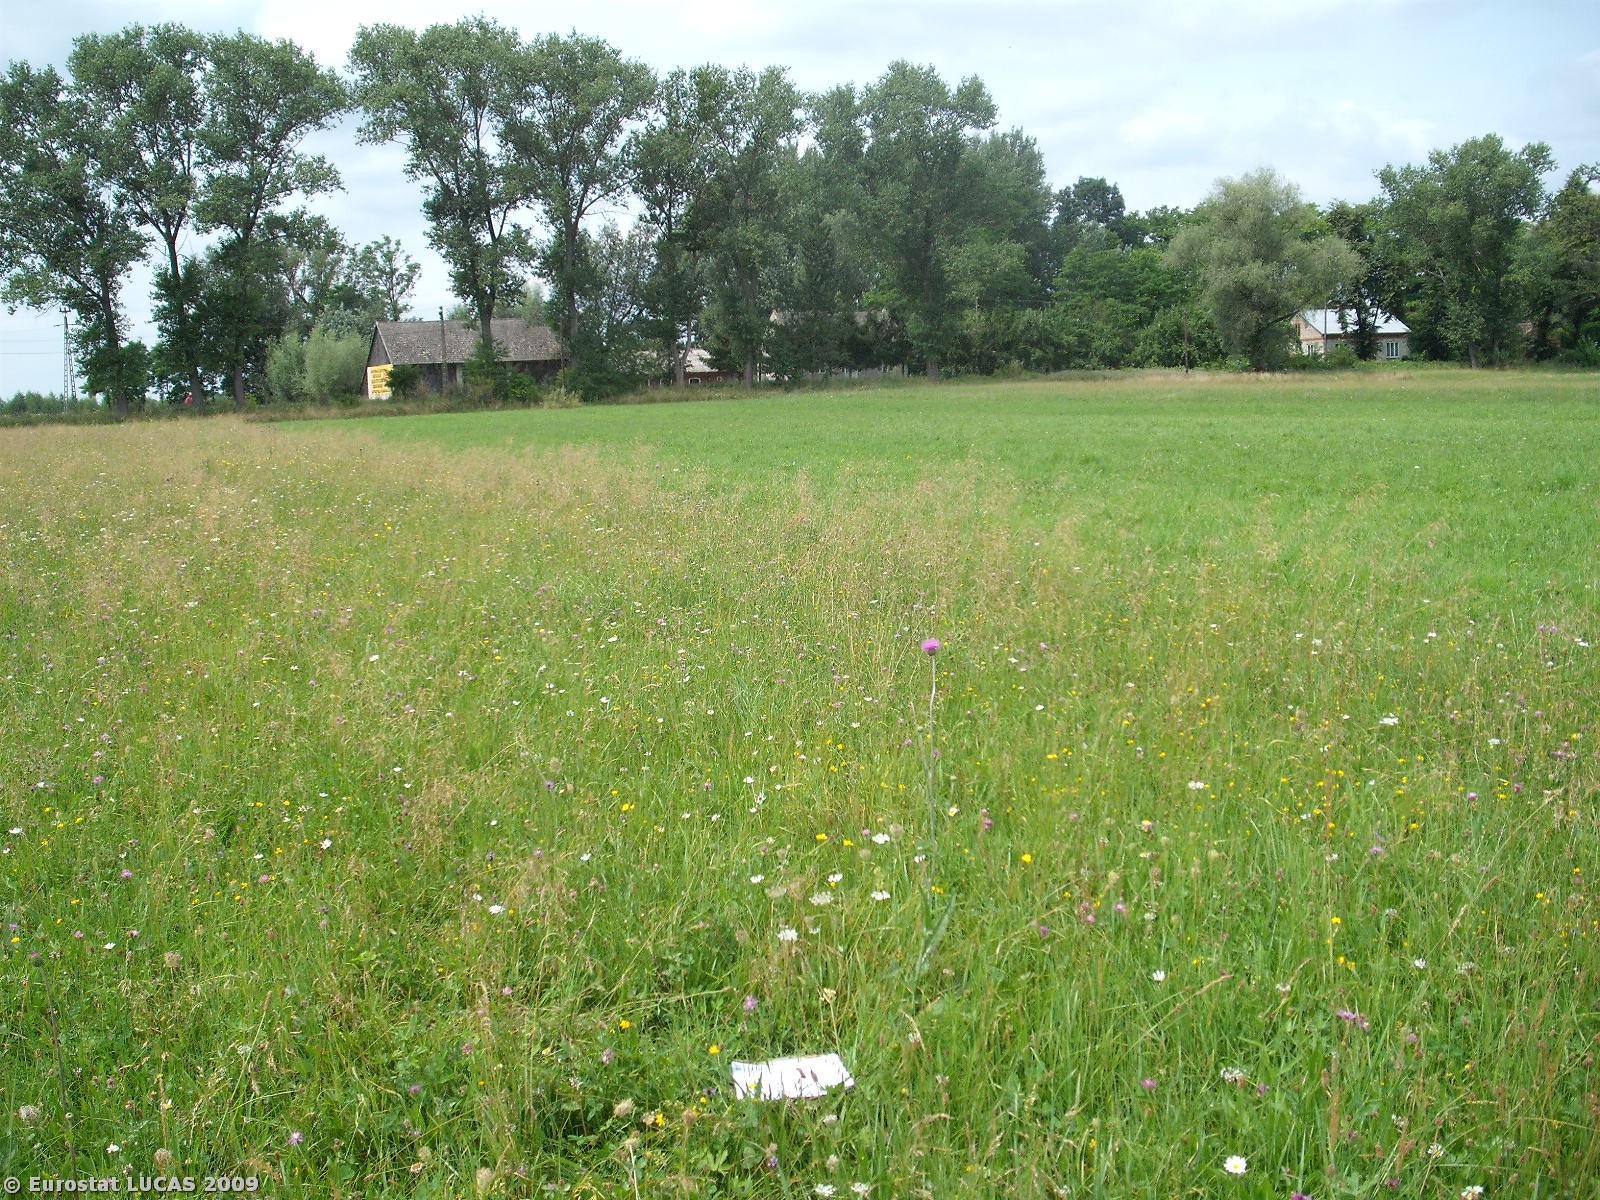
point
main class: Grassland
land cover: Grassland without tree/shrub cover
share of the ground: > 75 %
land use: Agriculture (excluding fallow land and kitchen gardens)
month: August
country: PL
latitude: 50.2332
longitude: 20.5954
